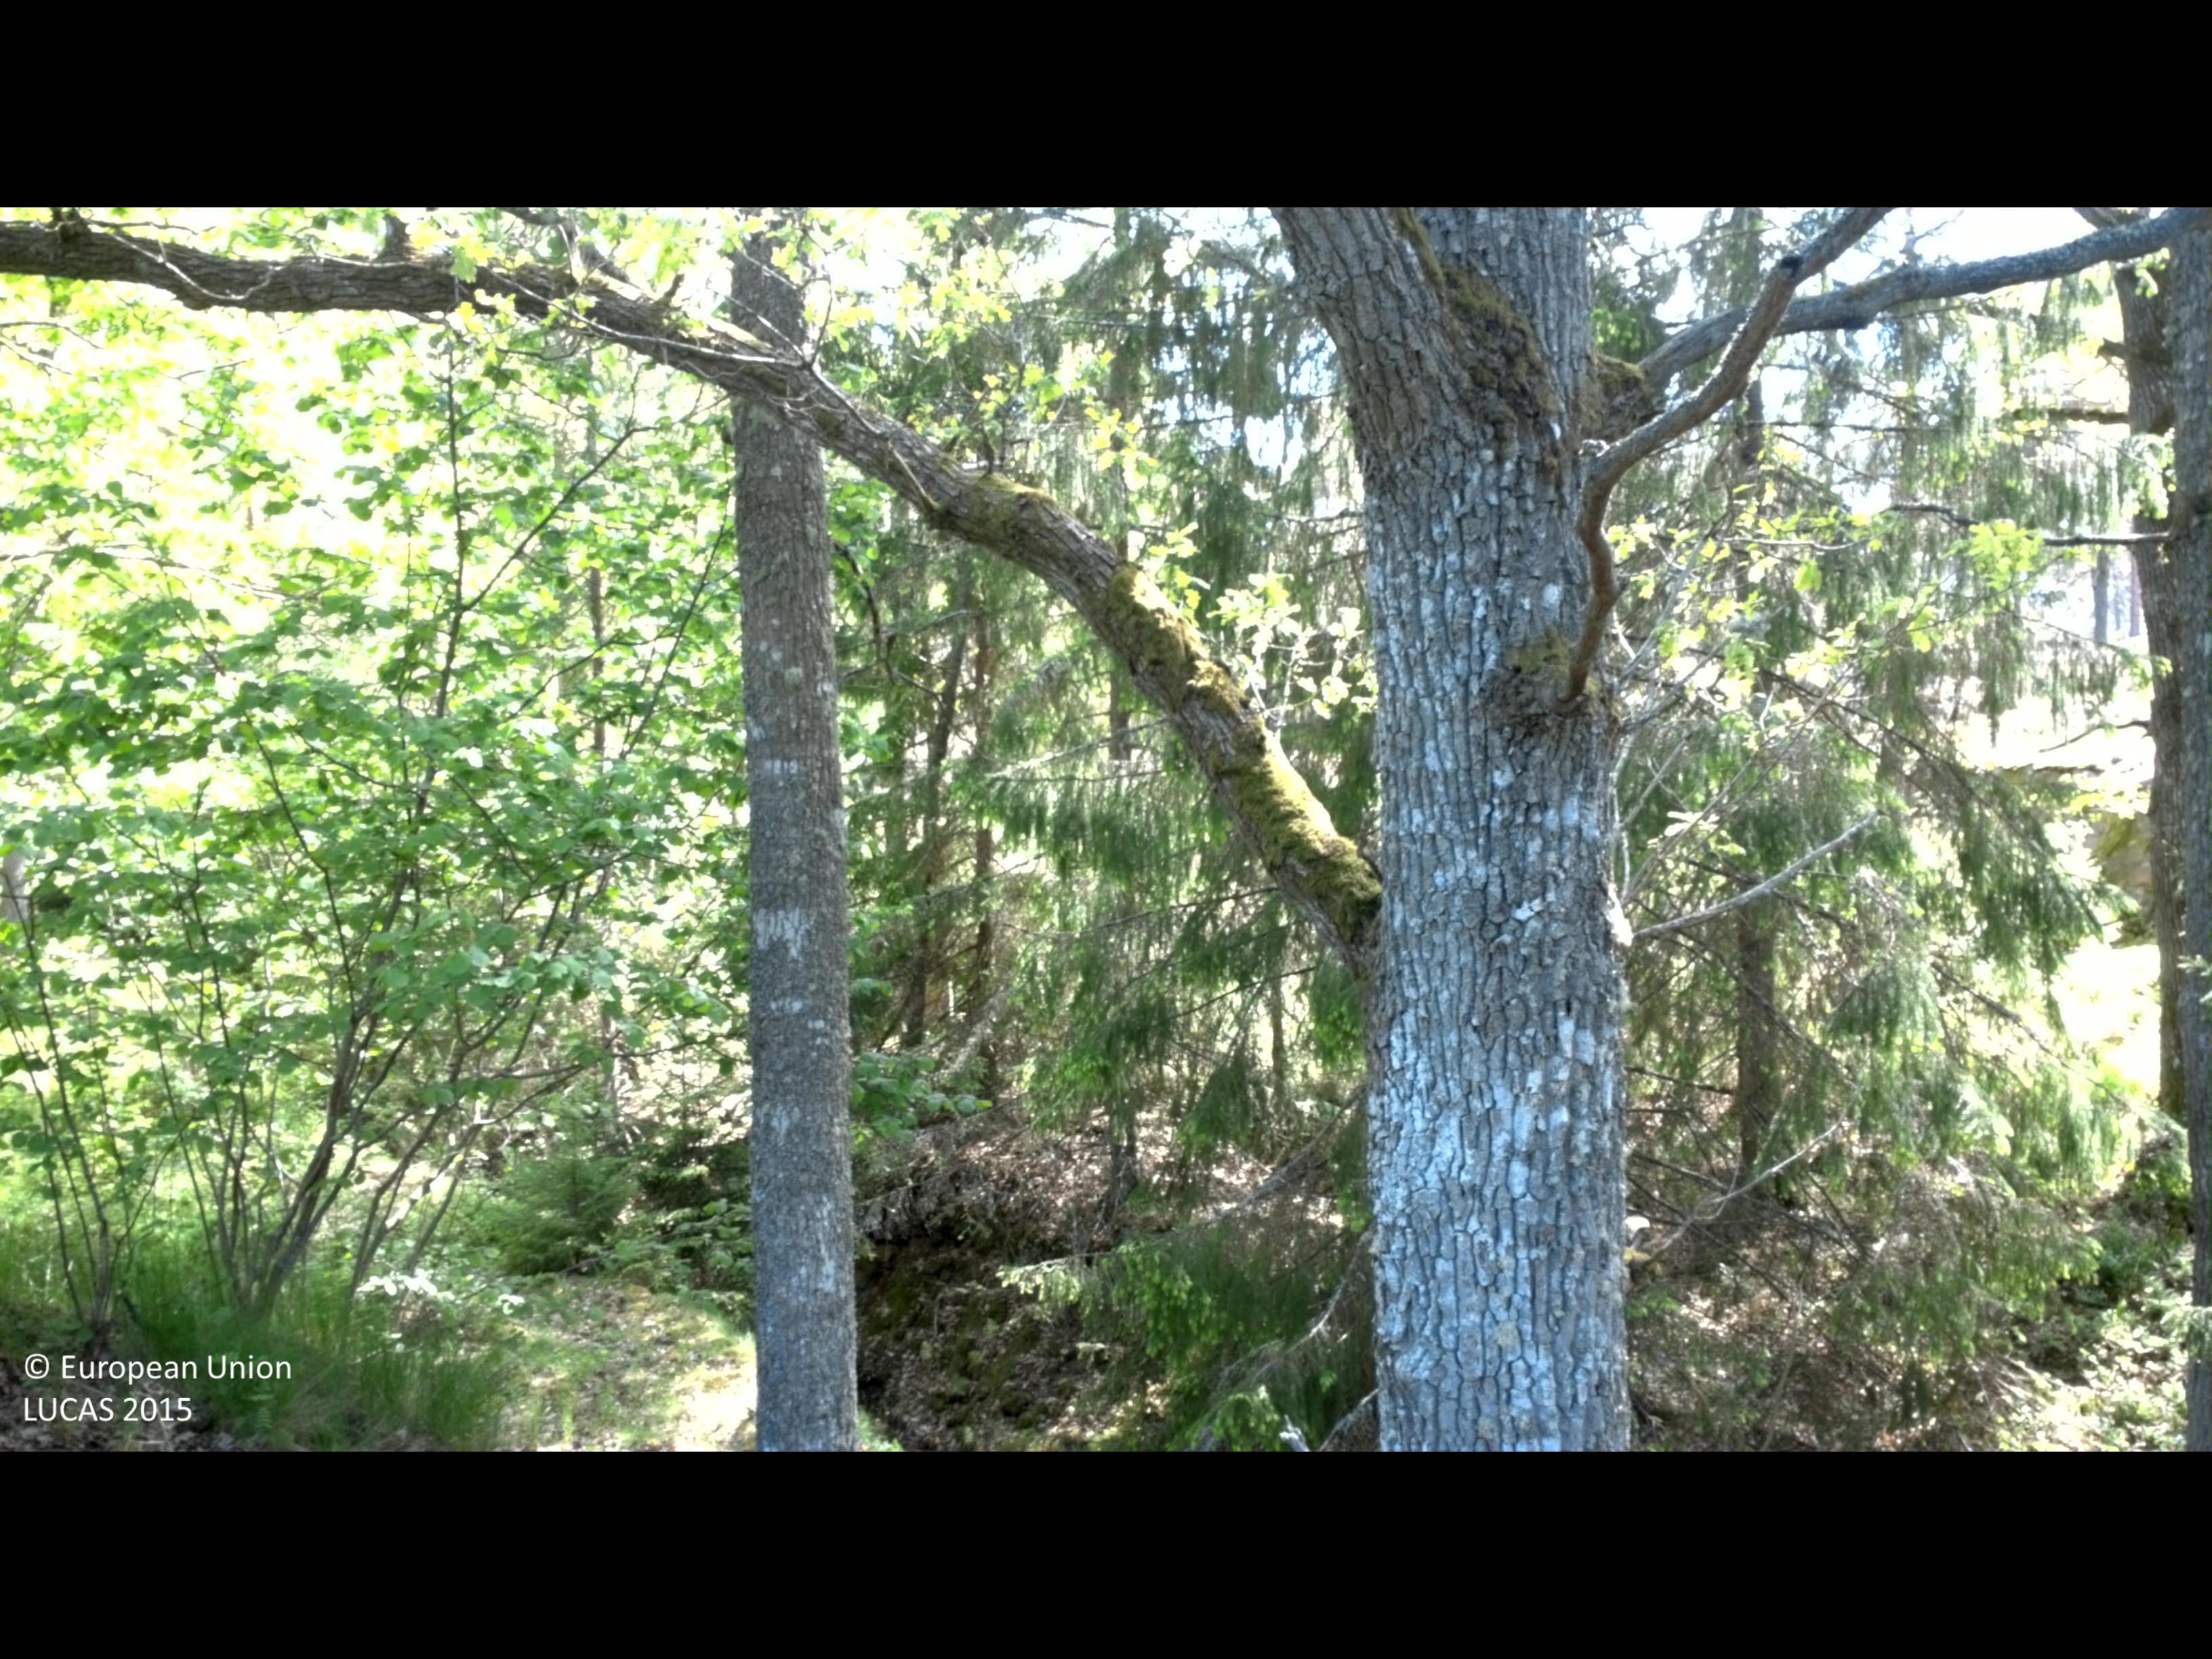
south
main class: Woodland
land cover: Broadleaved woodland
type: hemiboreal forest and nemoral coniferous forest and mixed broadleaved-coniferous forest
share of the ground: > 75 %
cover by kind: broadleaved forest trees 75 %, shrubs 10 %, herbaceous plants 10 %, coniferous forest trees 5 %
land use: Forestry
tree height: > 5 m
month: May
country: SE
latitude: 57.5535
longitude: 16.5669
